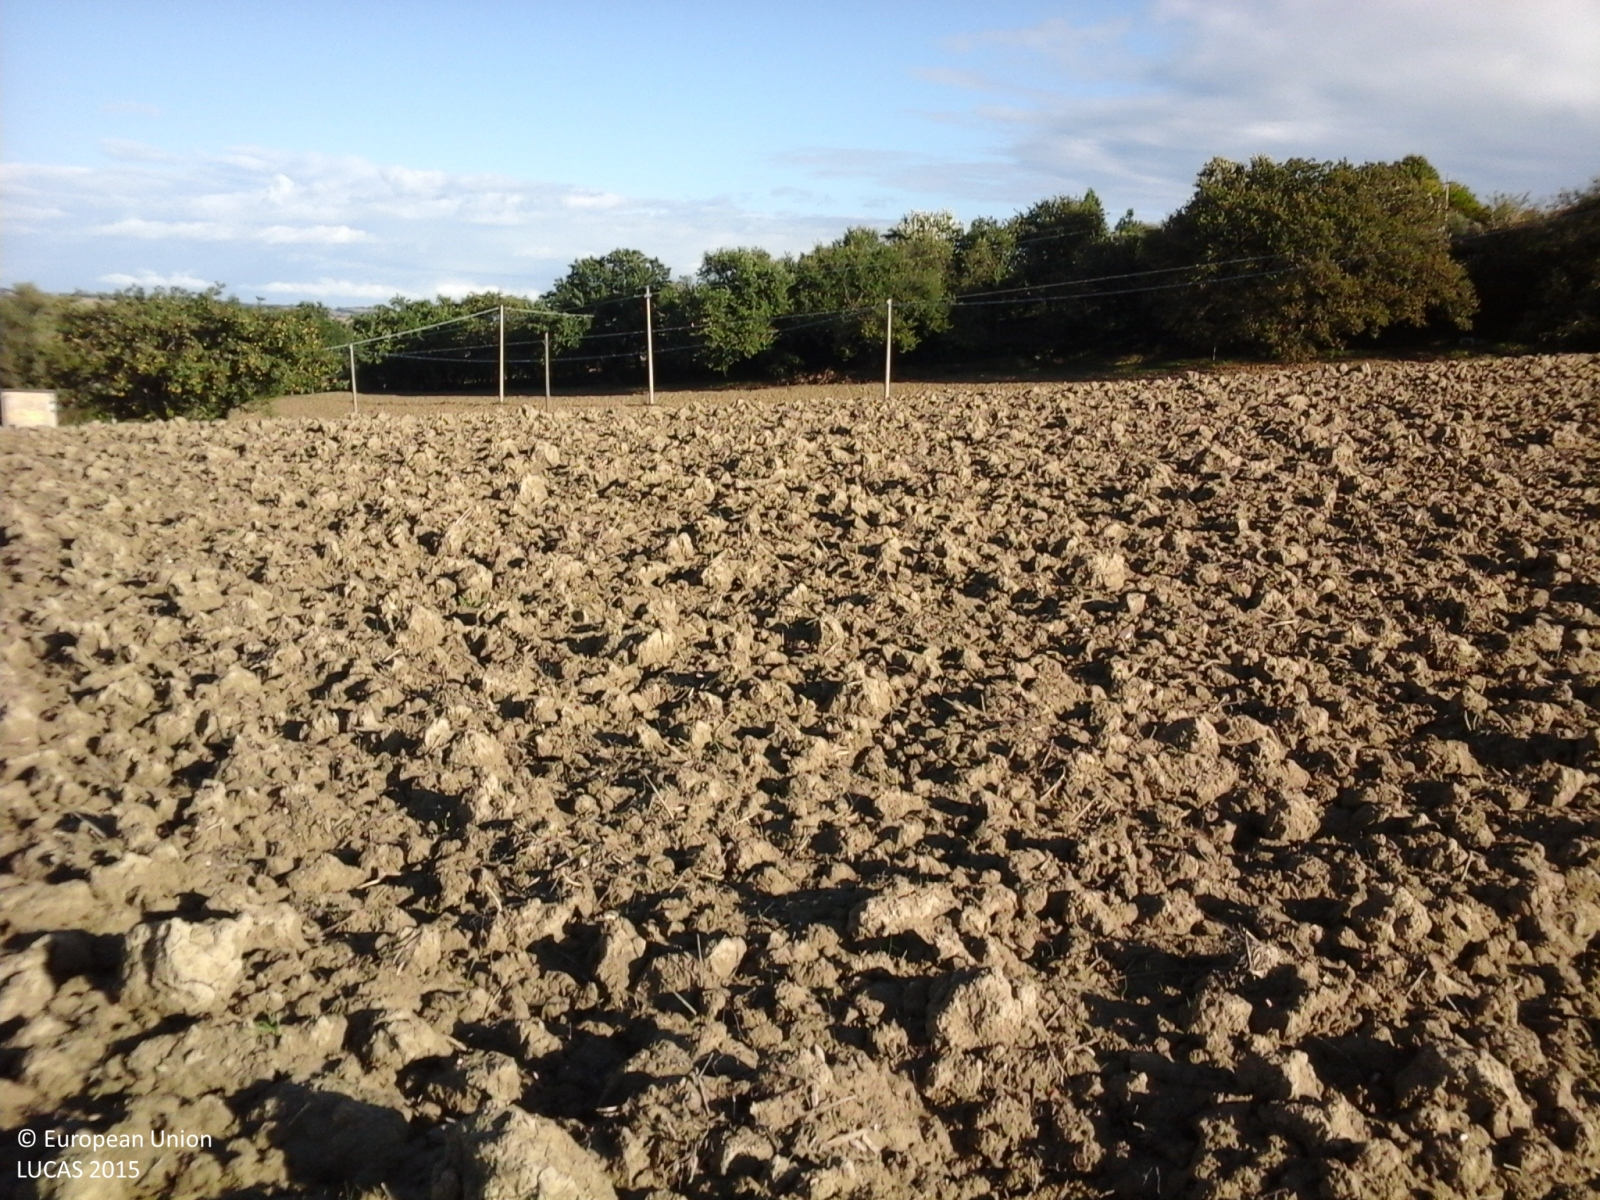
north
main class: Cropland
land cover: Durum wheat
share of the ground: < 10 %
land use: Agriculture (excluding fallow land and kitchen gardens)
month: October
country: IT
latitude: 43.6520
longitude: 13.1788
